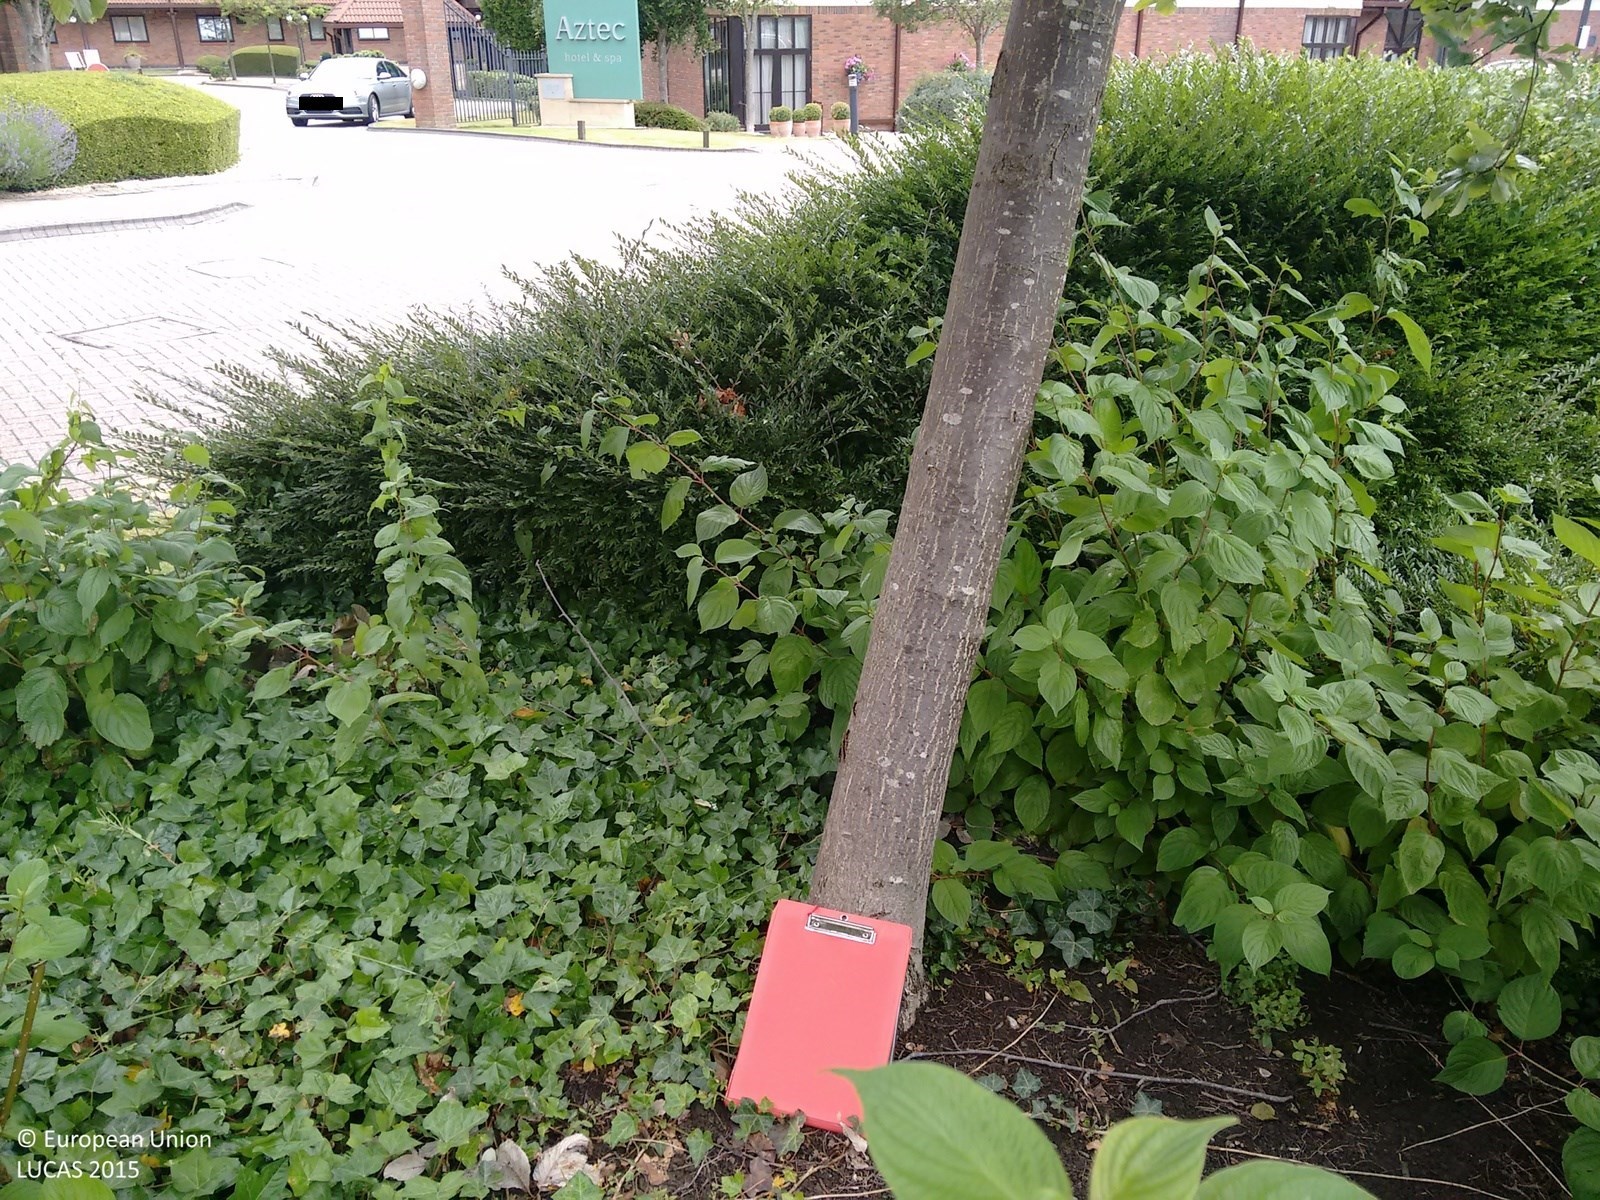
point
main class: Woodland
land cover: Broadleaved woodland
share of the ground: > 75 %
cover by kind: broadleaved forest trees 100 %
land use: Semi-natural and natural areas not in use
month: July
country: GB
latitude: 51.5423
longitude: -2.5688
